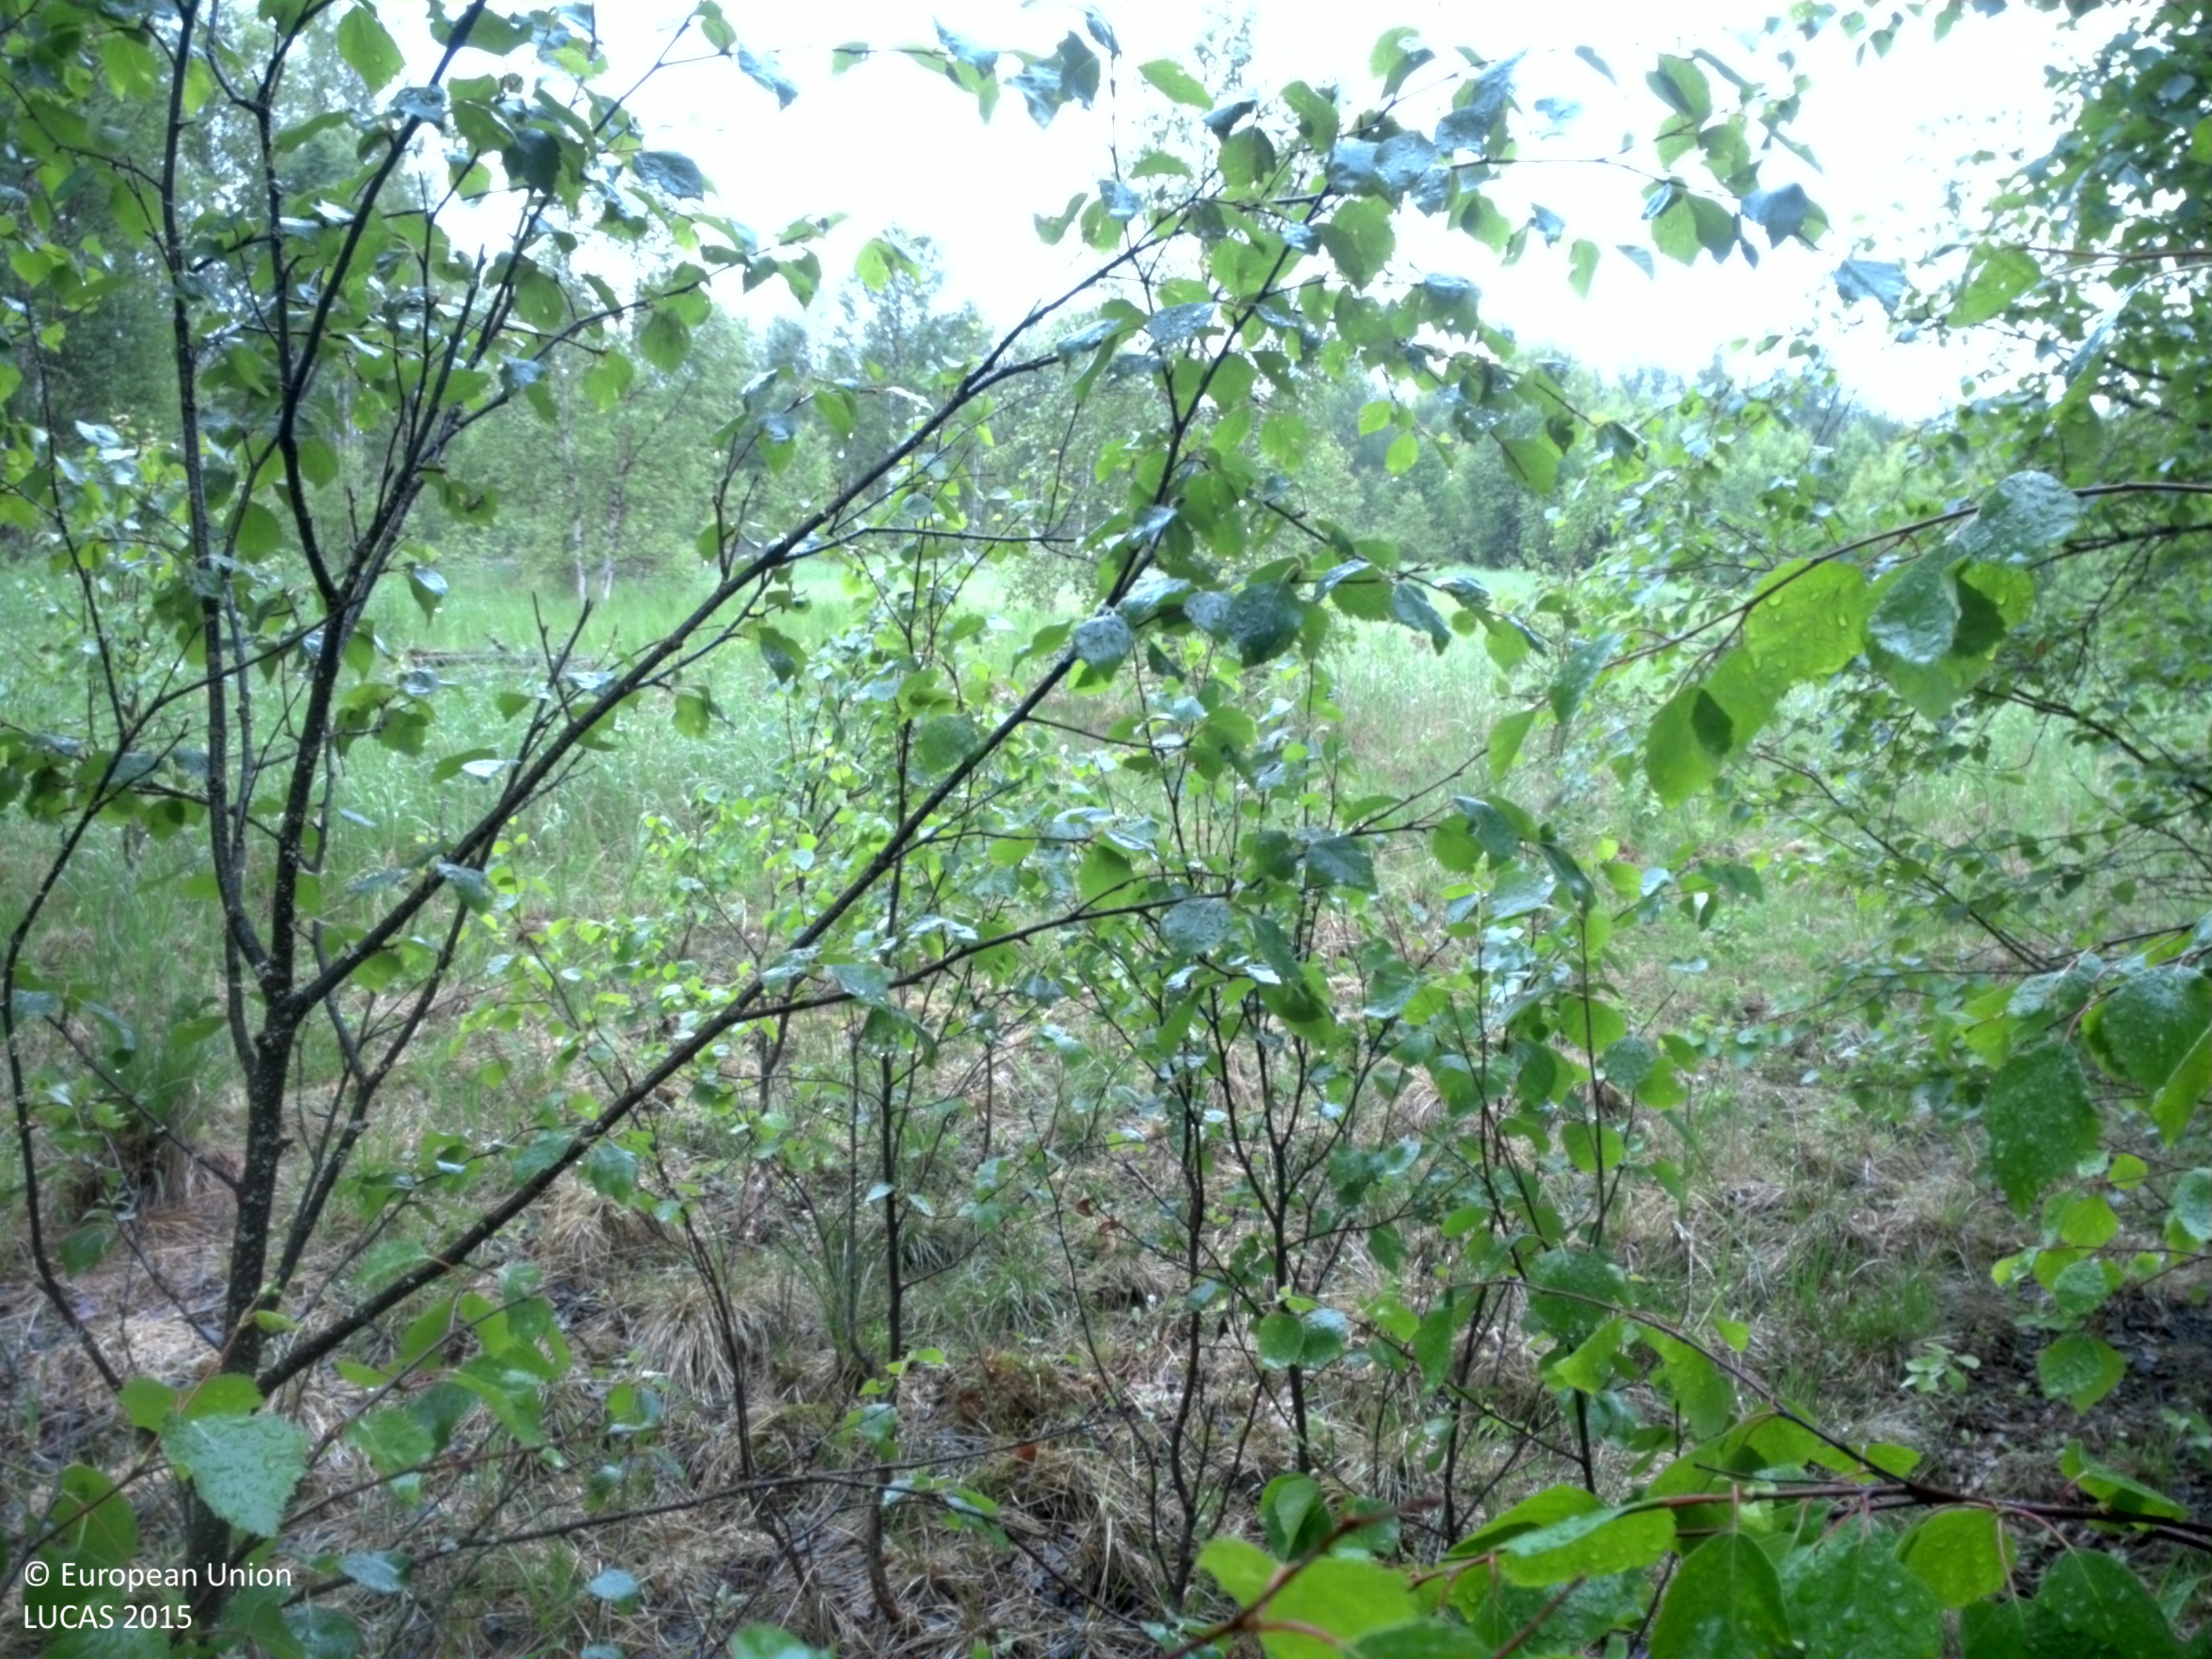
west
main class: Woodland
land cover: Broadleaved woodland
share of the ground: > 75 %
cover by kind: broadleaved forest trees 85 %, shrubs 5 %, herbaceous plants 5 %, lichens and mosses 5 %
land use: Forestry
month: June
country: SE
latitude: 66.3761
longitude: 22.7906
